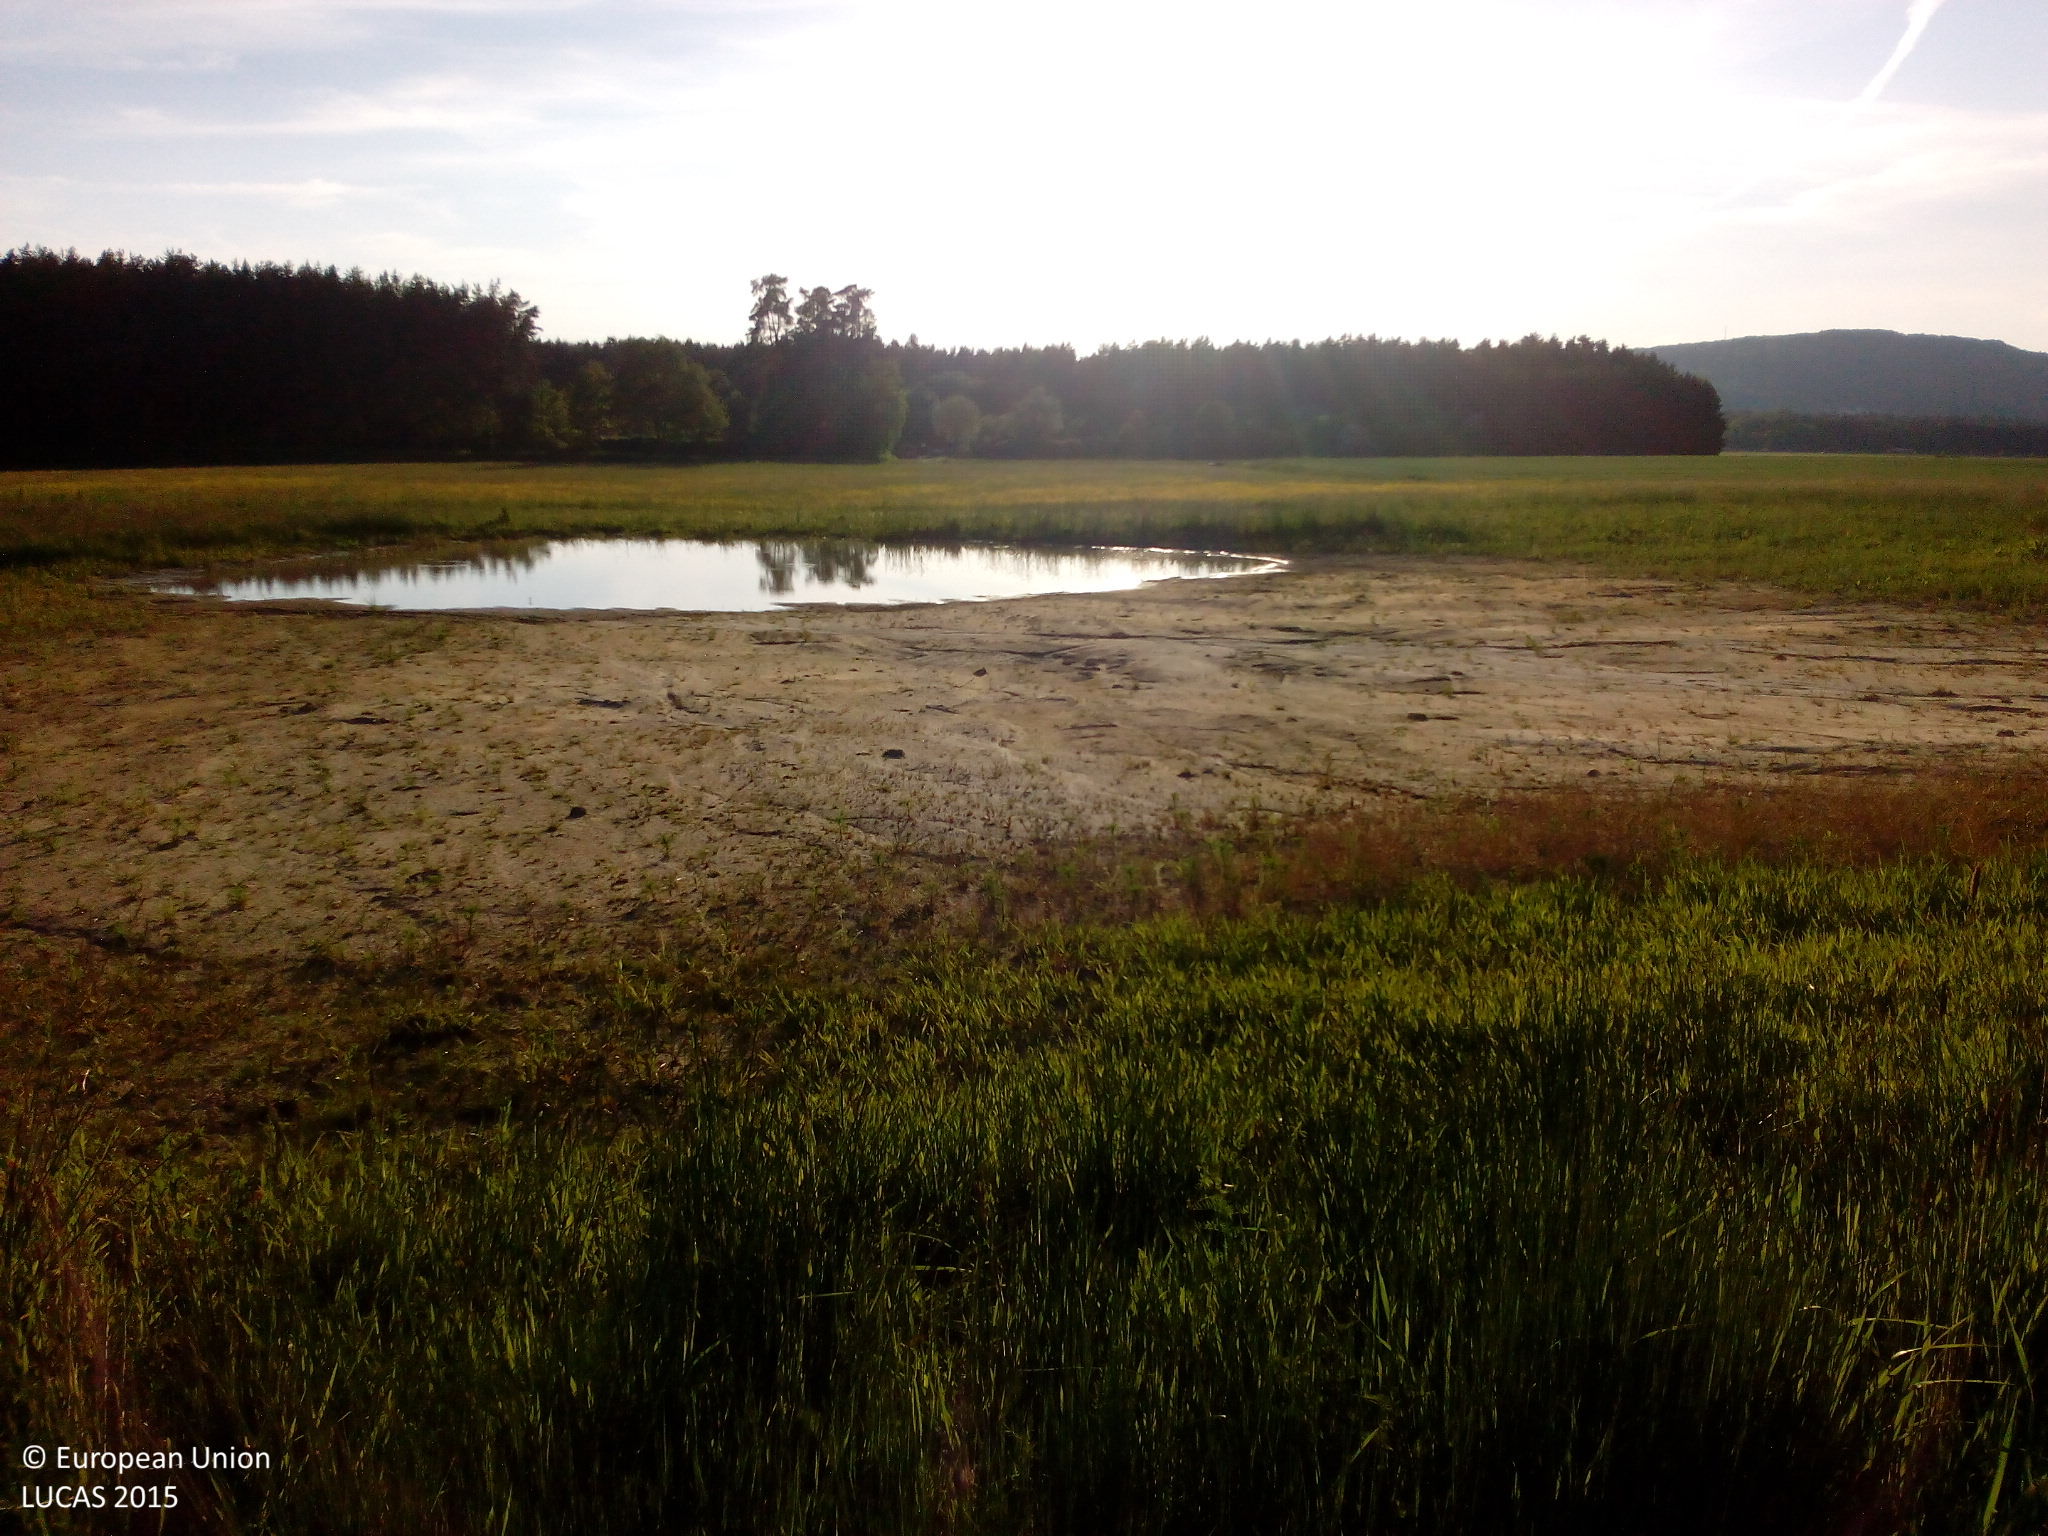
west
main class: Grassland
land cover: Grassland without tree/shrub cover
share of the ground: > 75 %
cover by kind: herbaceous plants 95 %, unconsolidated bare surface 5 %
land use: Agriculture (excluding fallow land and kitchen gardens)
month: May
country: DE
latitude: 49.2214
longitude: 11.4686
